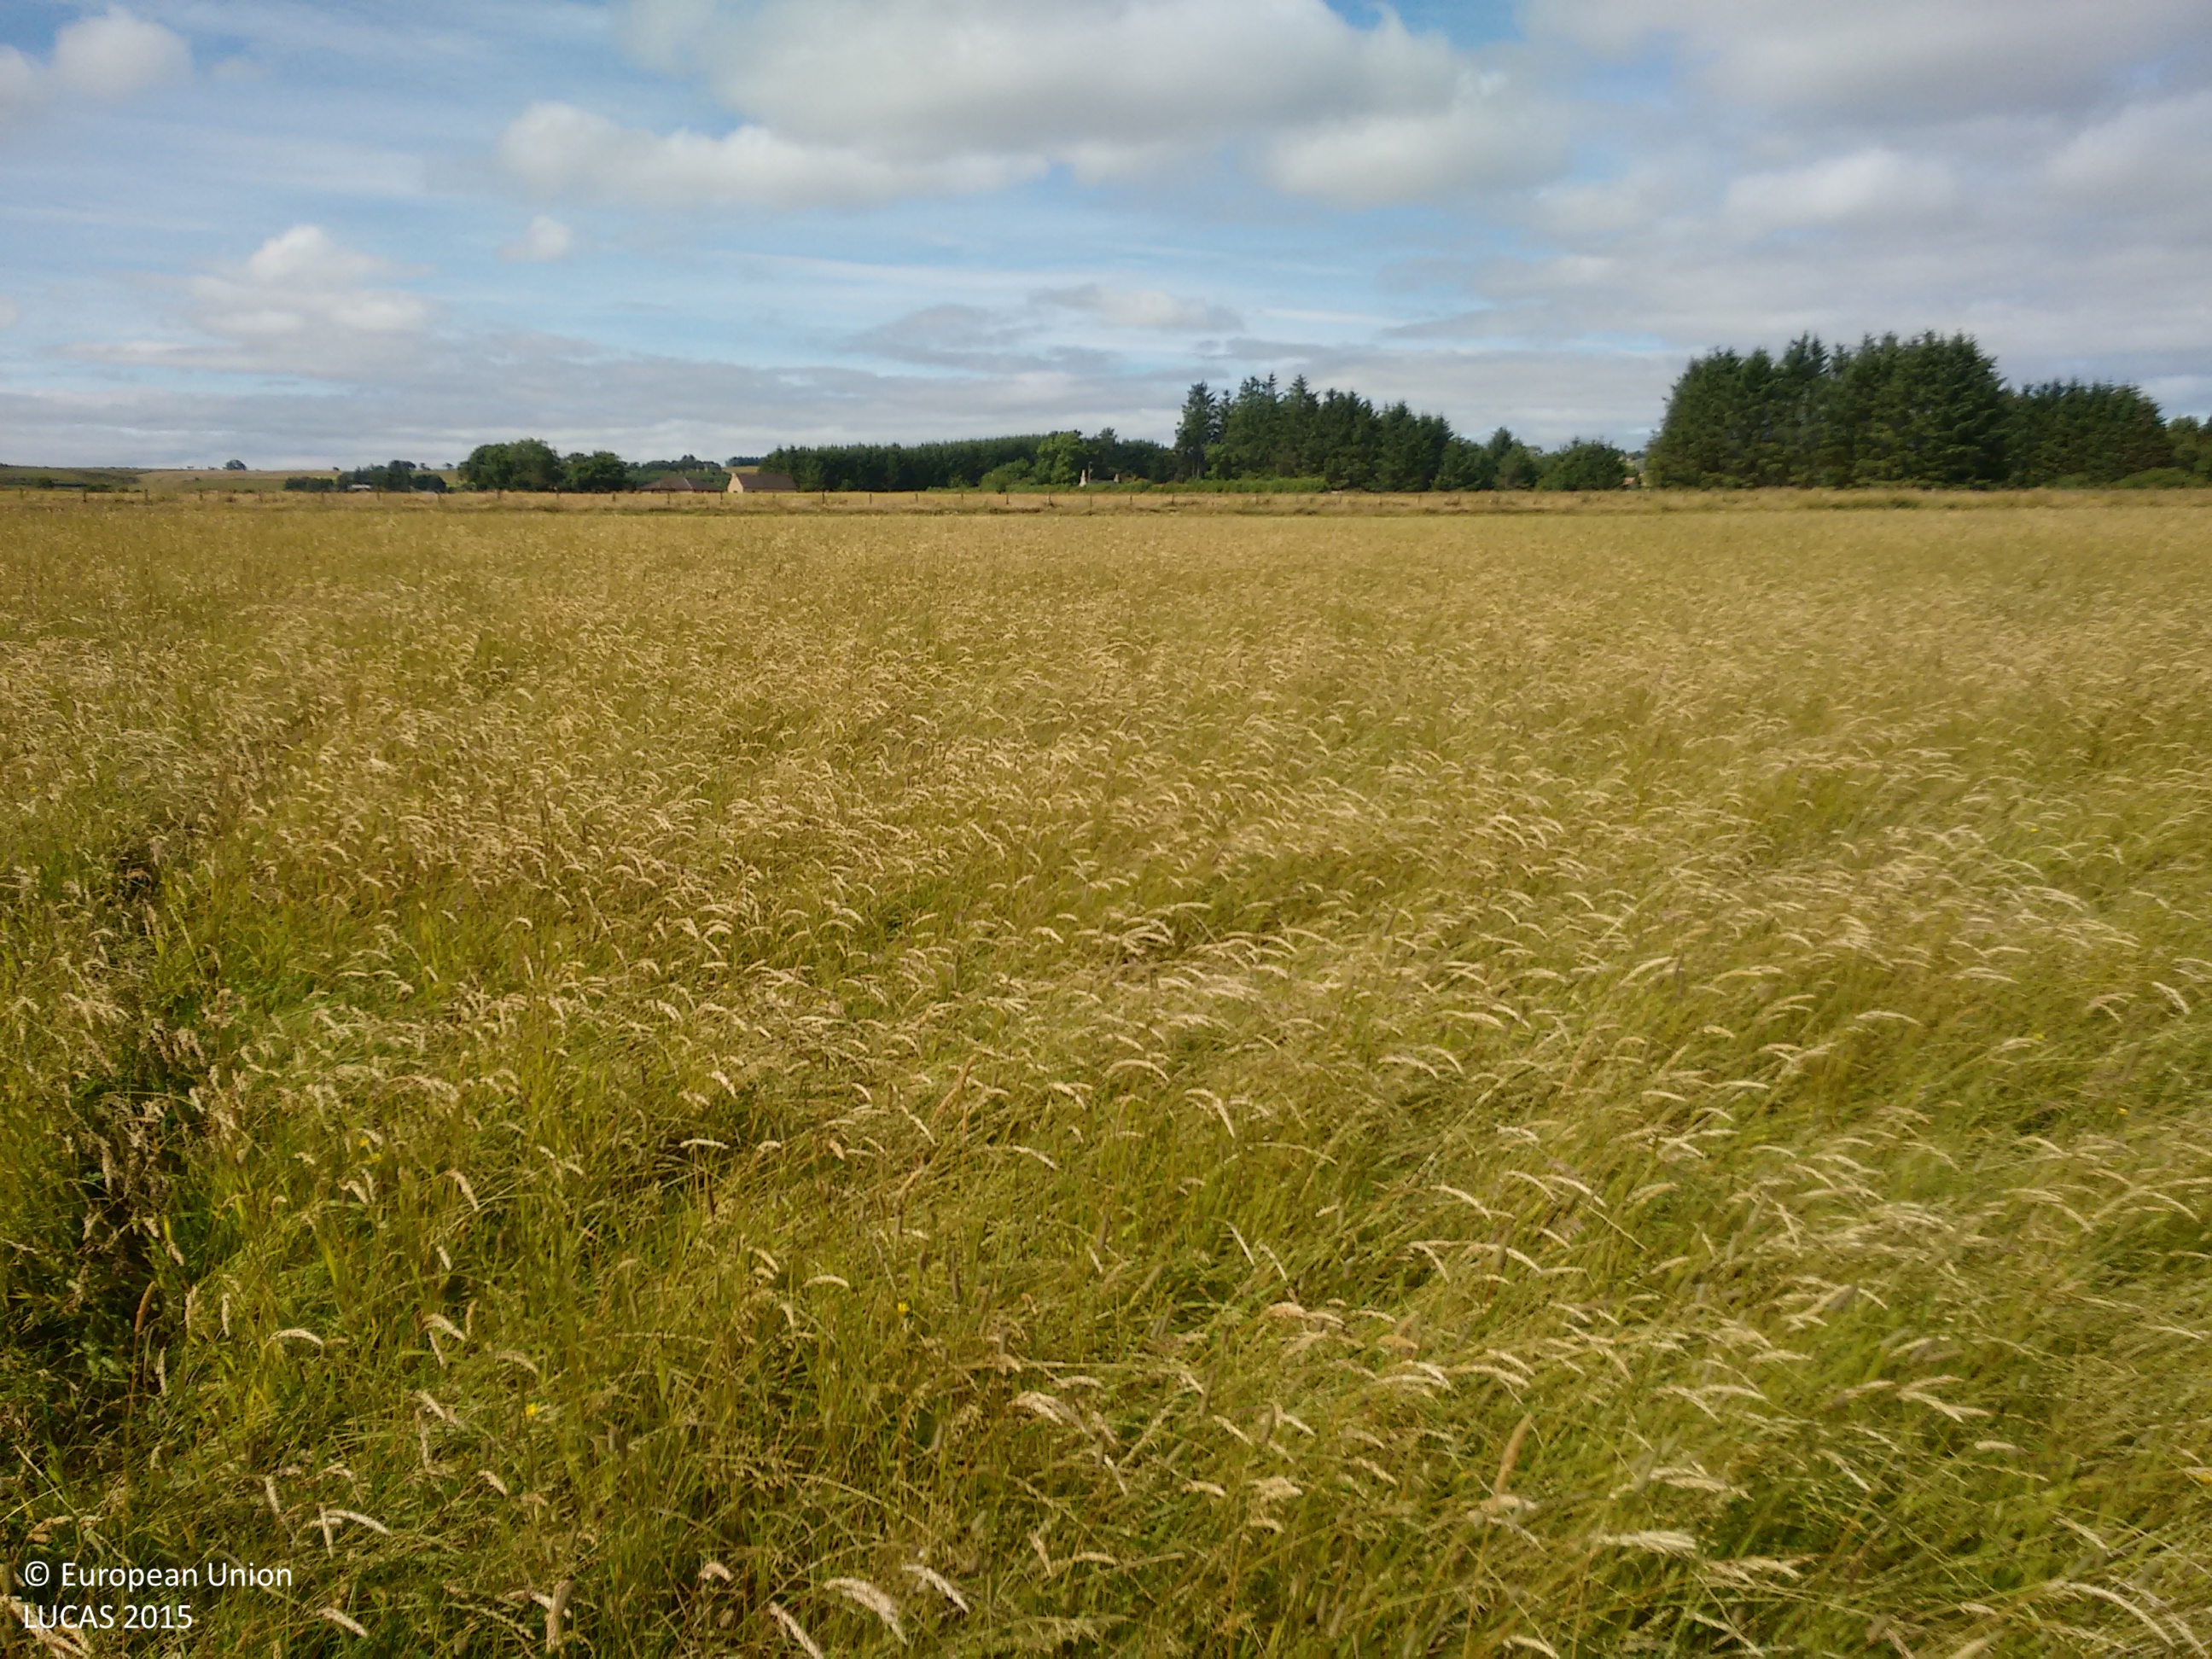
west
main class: Grassland
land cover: Grassland without tree/shrub cover
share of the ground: > 75 %
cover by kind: herbaceous plants 100 %
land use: Agriculture (excluding fallow land and kitchen gardens)
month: August
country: GB
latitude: 57.5744
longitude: -2.9180
